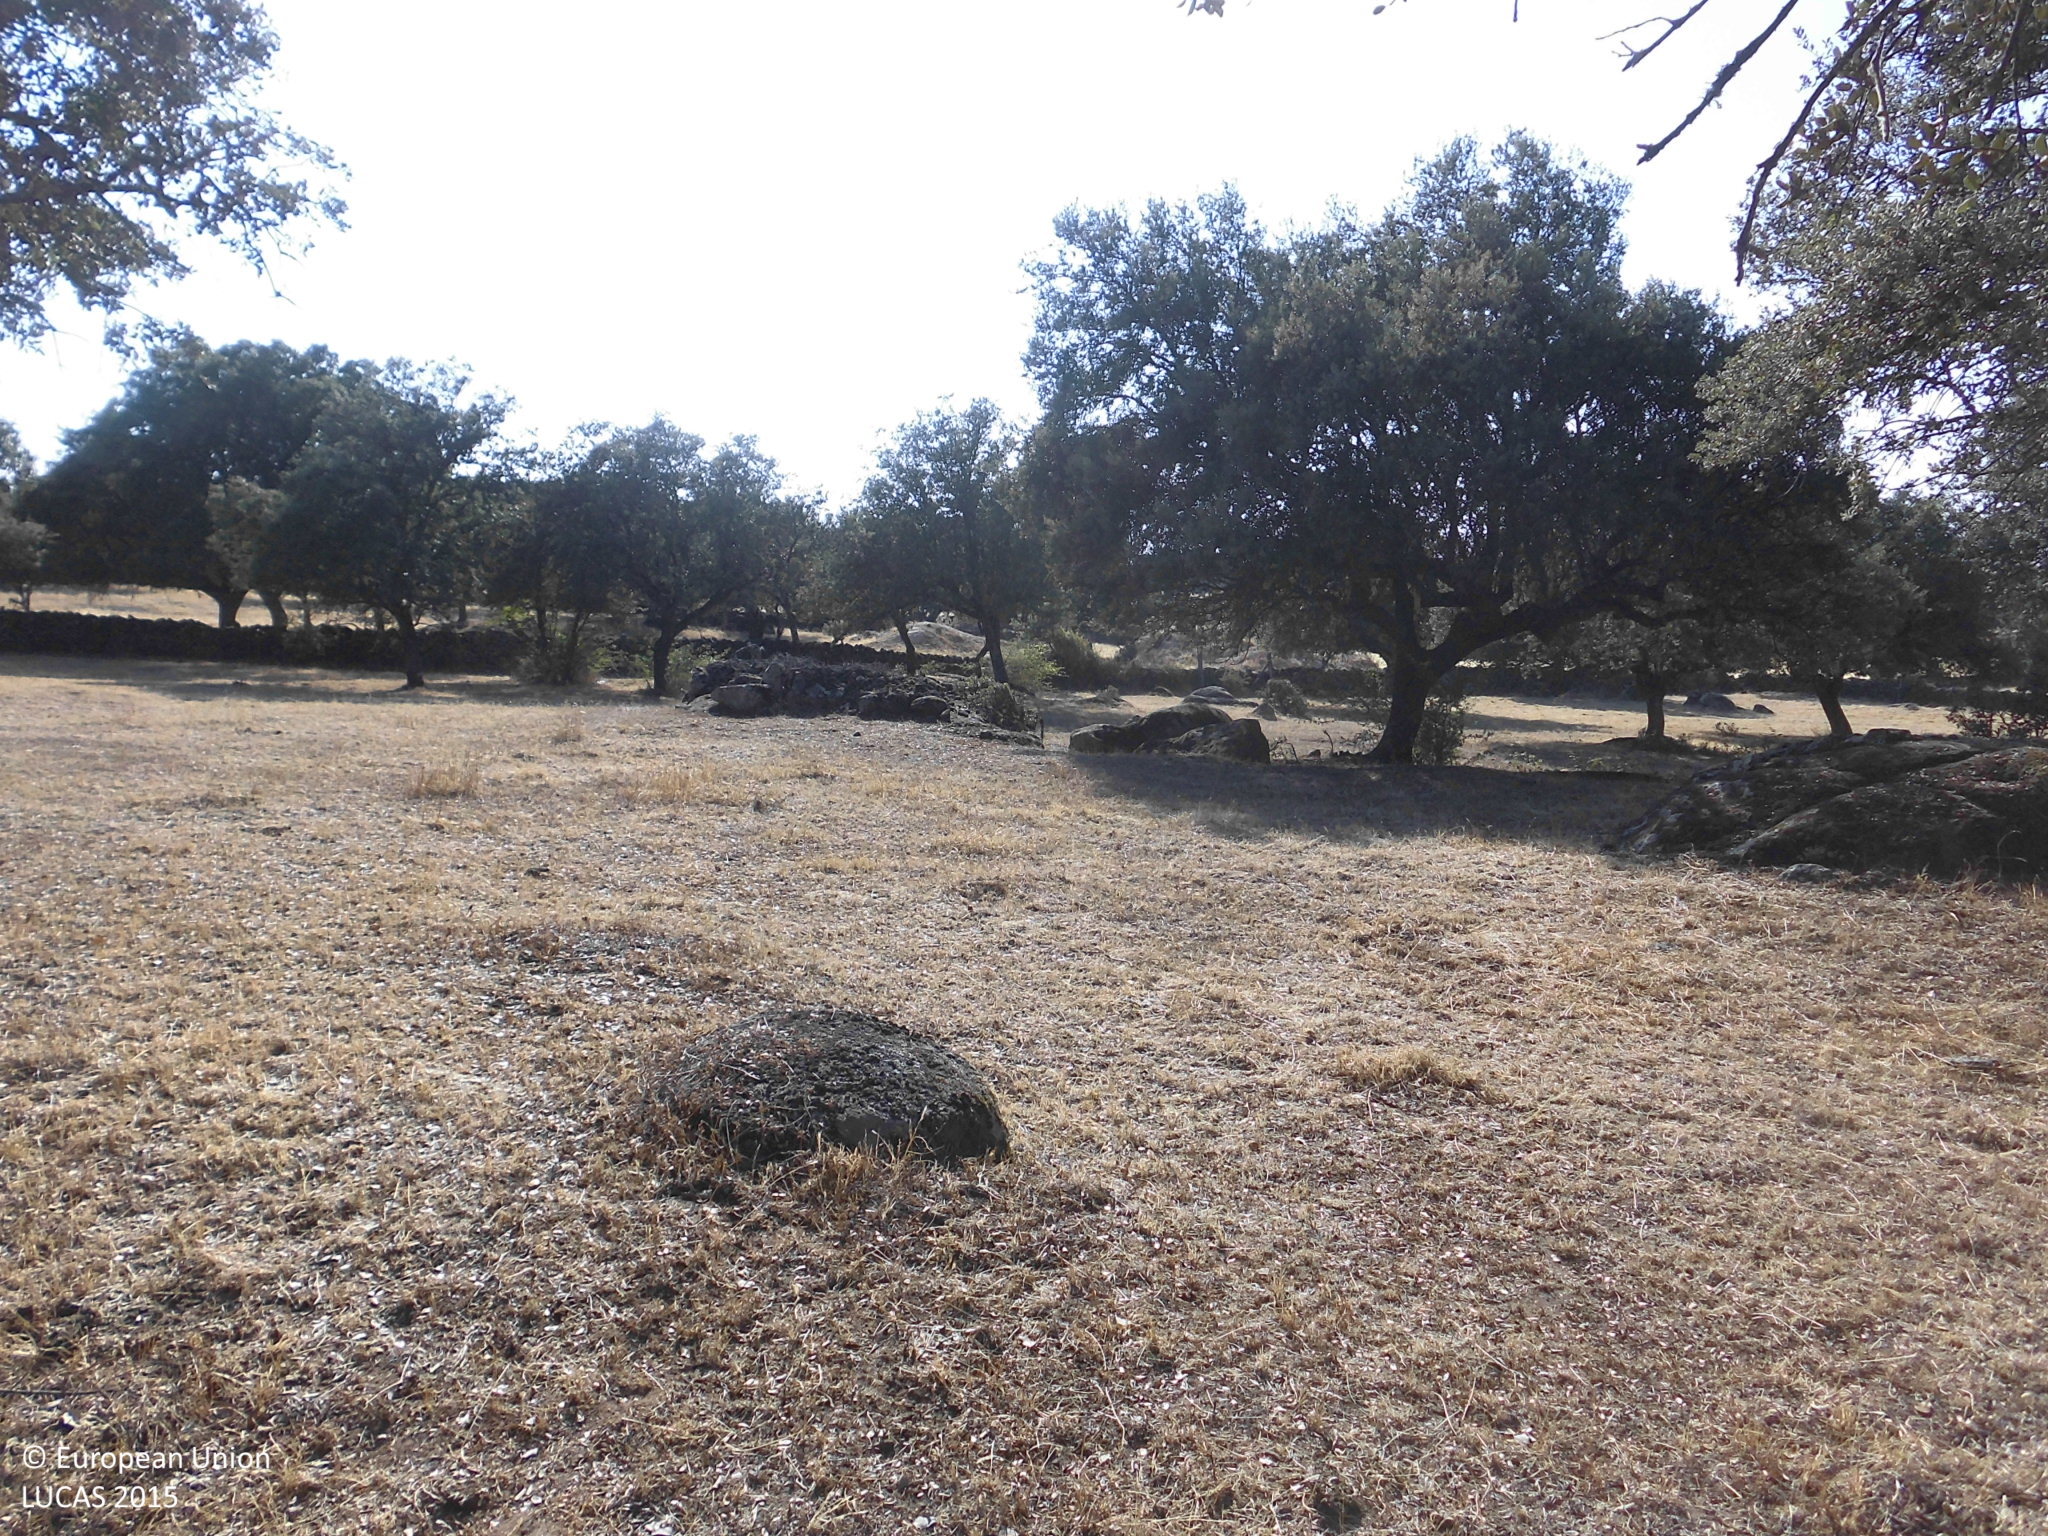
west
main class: Woodland
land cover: Broadleaved woodland
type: broadleaved evergreen forest
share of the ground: 25 - 50 %
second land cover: Grassland without tree/shrub cover
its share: > 75 %
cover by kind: herbaceous plants 70 %, broadleaved forest trees 30 %
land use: Forestry
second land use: Agriculture (excluding fallow land and kitchen gardens)
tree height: > 5 m
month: July
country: ES
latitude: 40.1317
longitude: -6.1645
